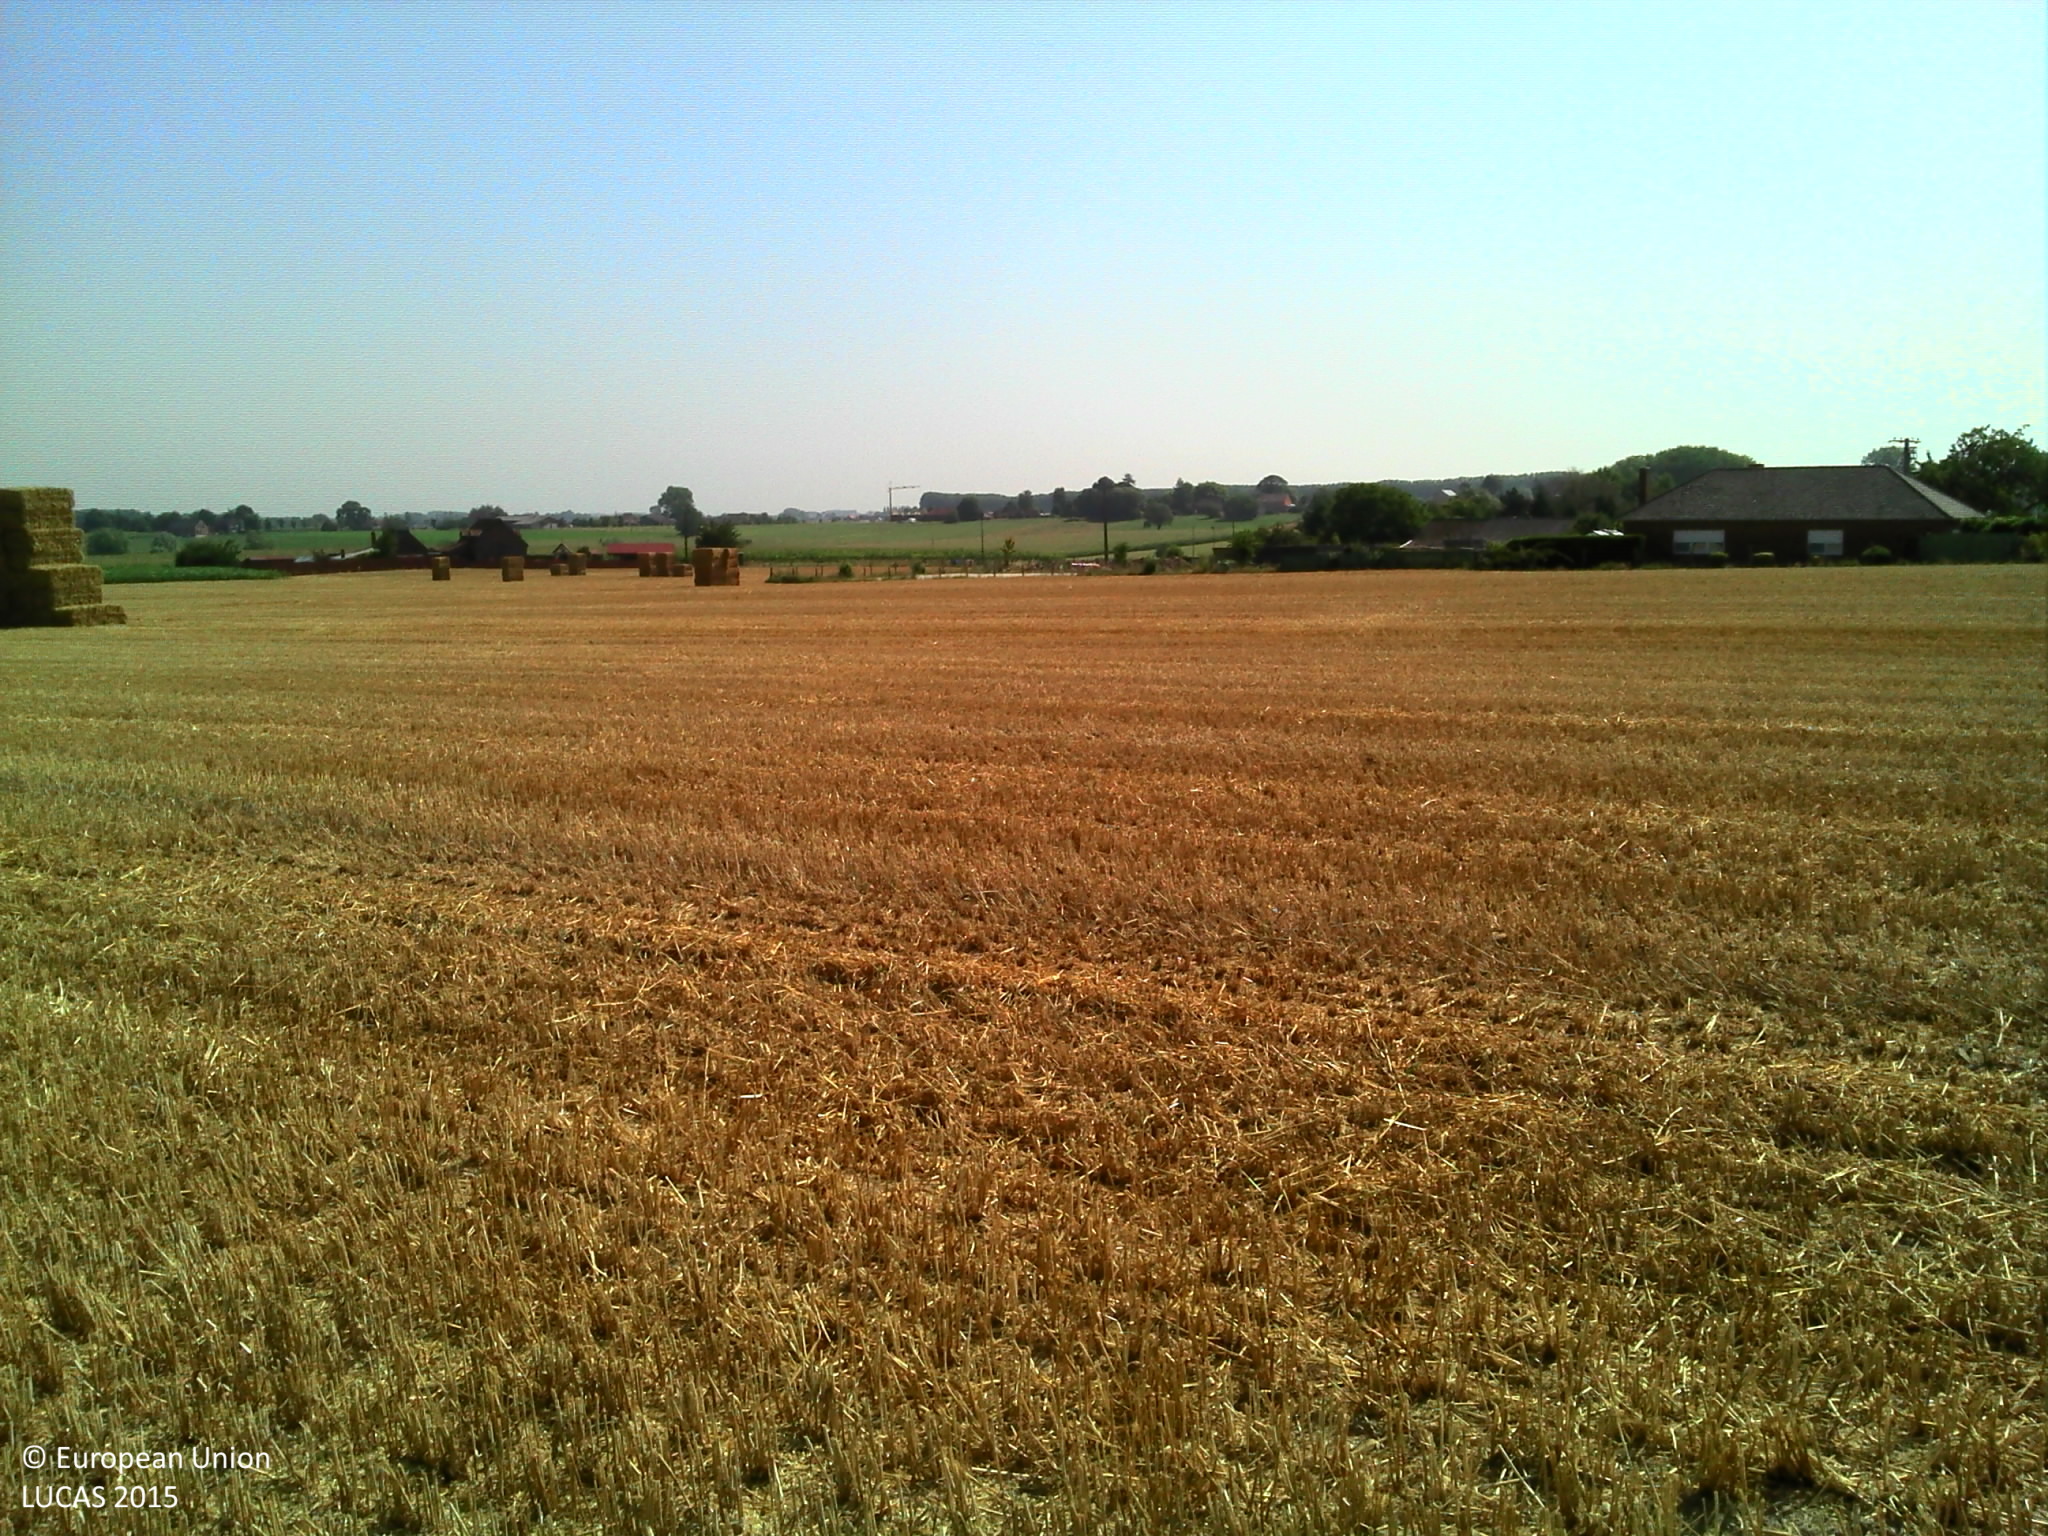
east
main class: Cropland
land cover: Common wheat
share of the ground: < 10 %
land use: Agriculture (excluding fallow land and kitchen gardens)
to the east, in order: Common wheat; Artificial constructions in urban areas; Grassland without tree/shrub cover; Fences; Grass margins; Other bare soil; Grass margins; Fences; Grassland without tree/shrub cover
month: August
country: BE
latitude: 50.6564
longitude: 3.9824
